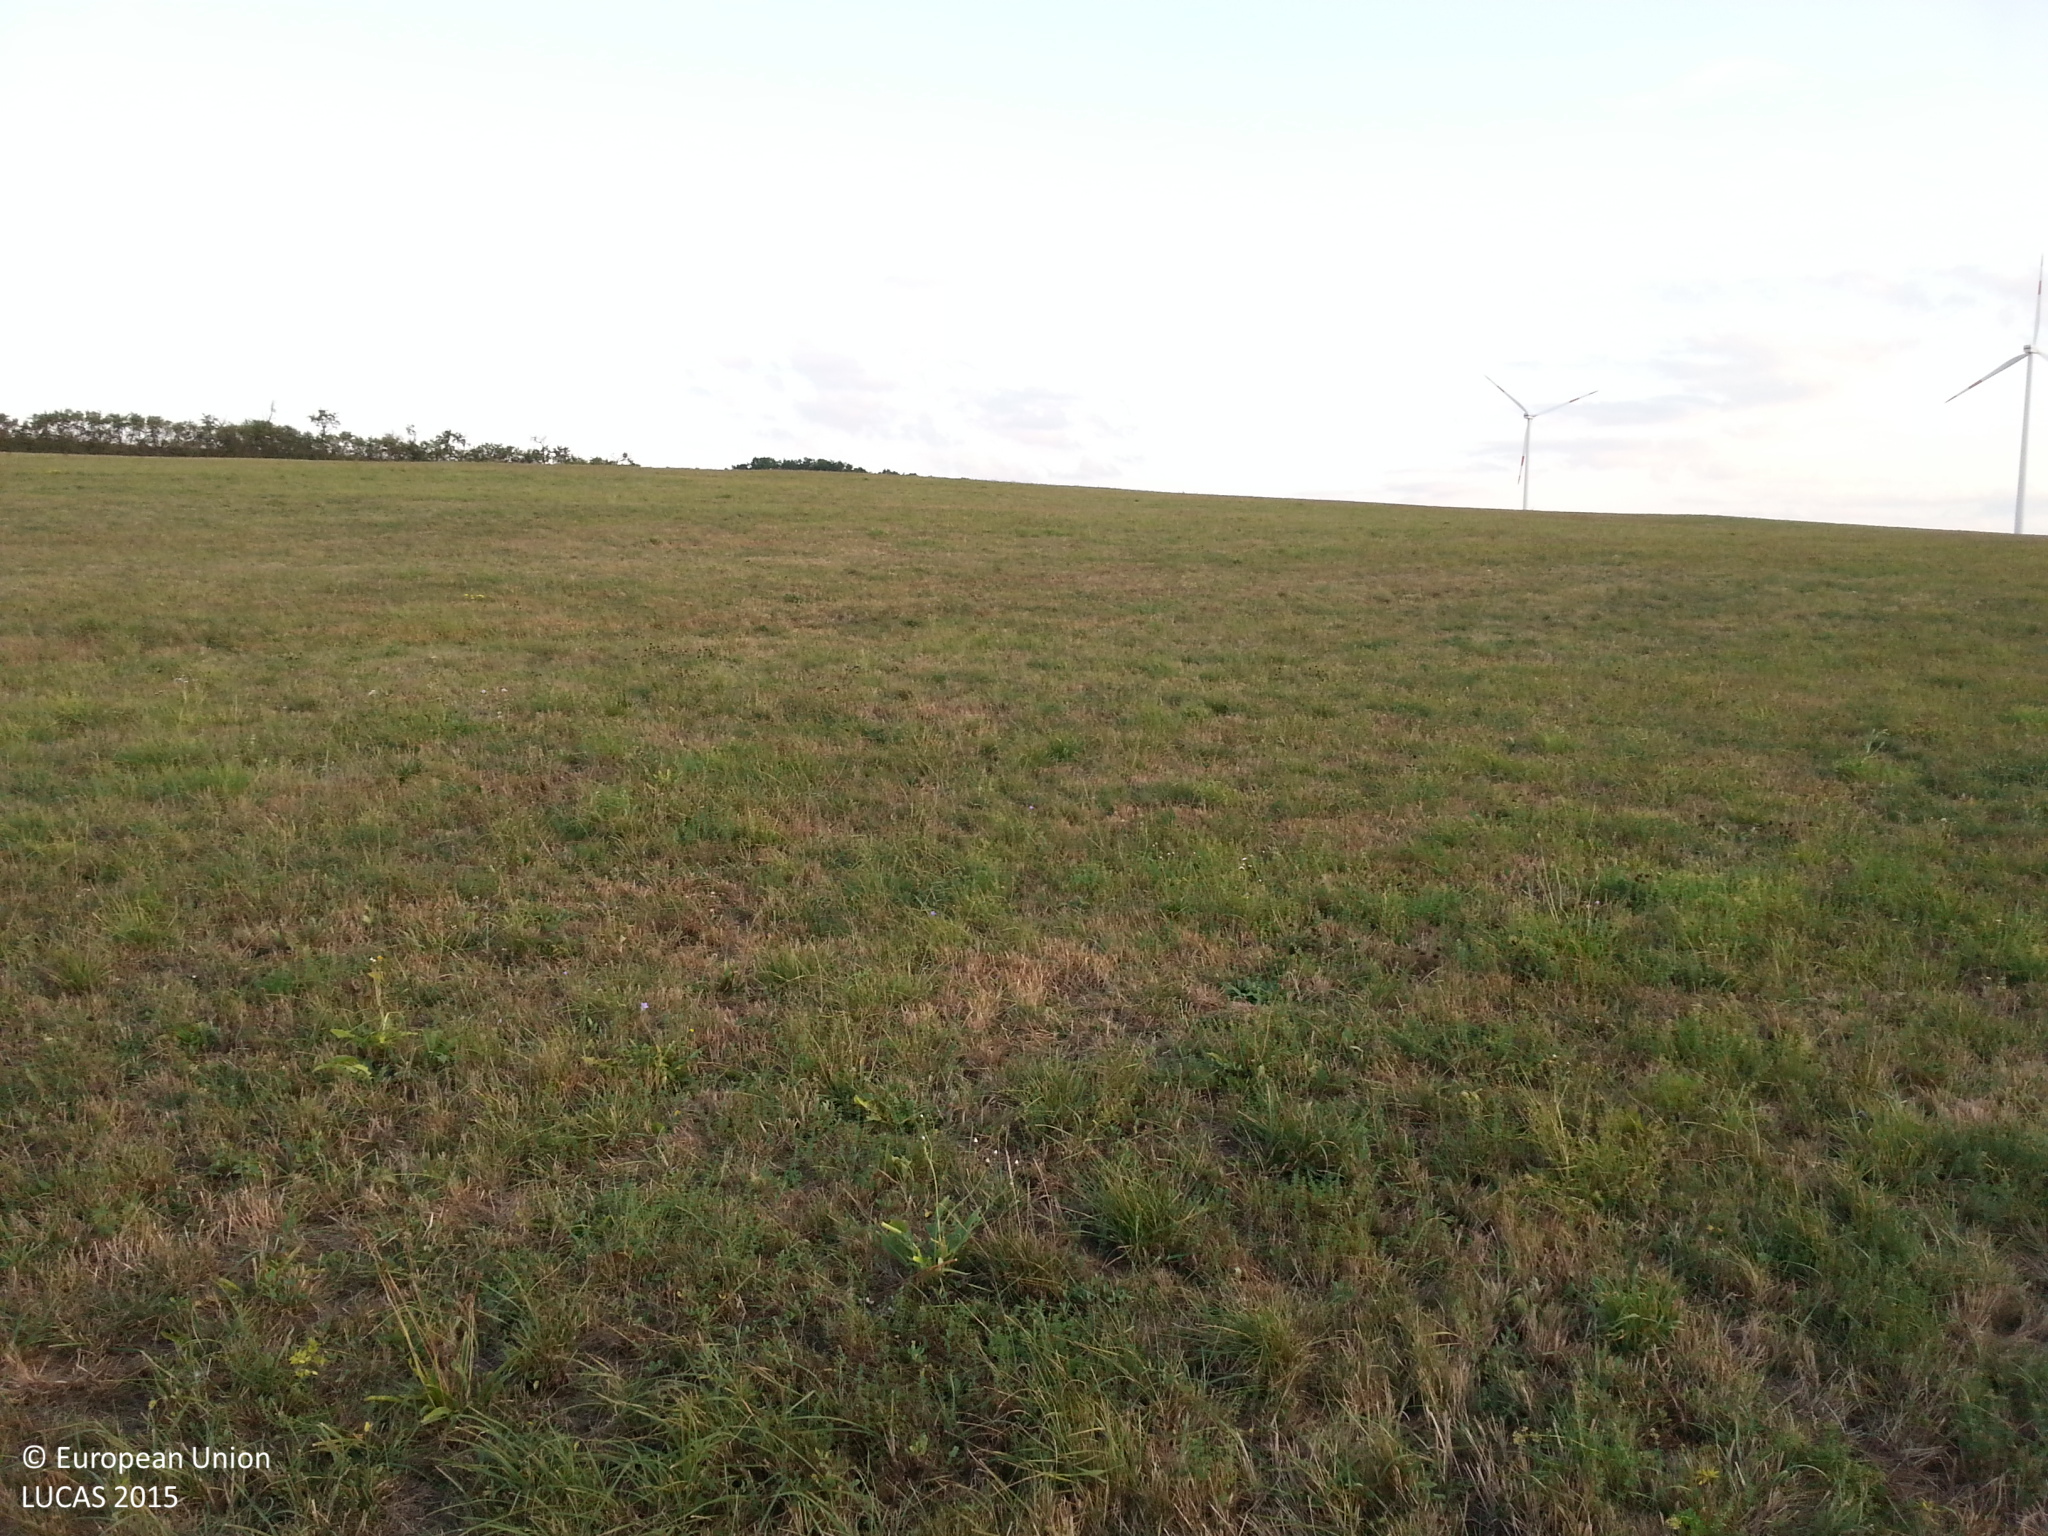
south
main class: Grassland
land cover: Grassland without tree/shrub cover
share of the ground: > 75 %
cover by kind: herbaceous plants 100 %
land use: Agriculture (excluding fallow land and kitchen gardens)
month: August
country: DE
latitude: 49.1951
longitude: 9.9588
